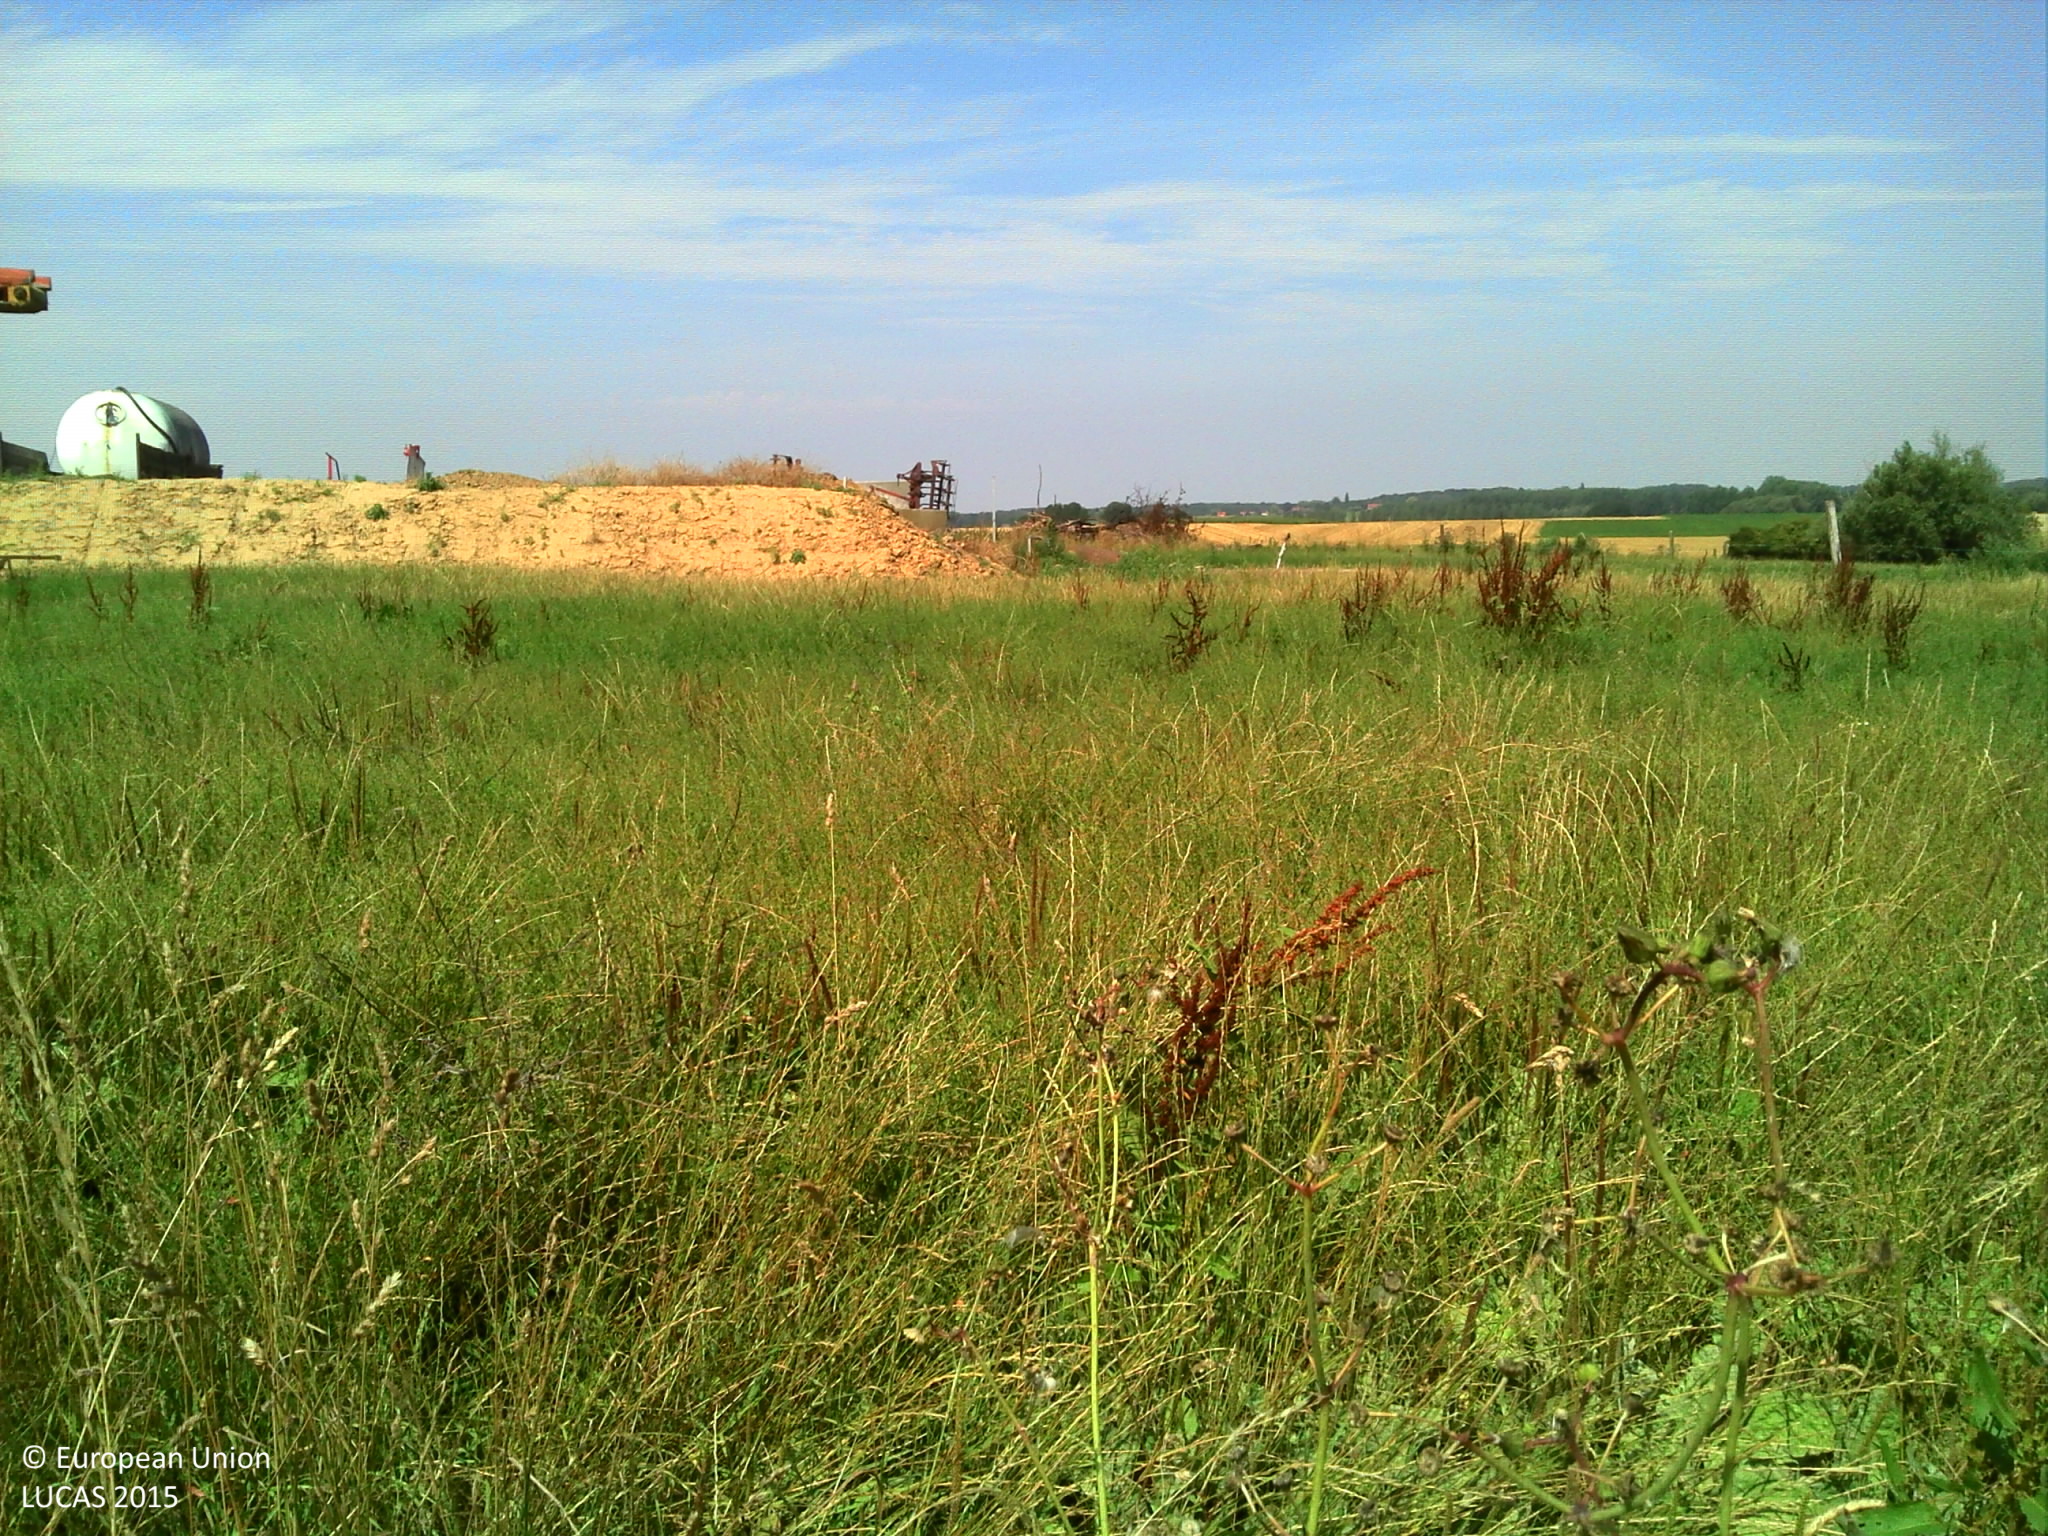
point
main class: Grassland
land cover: Grassland without tree/shrub cover
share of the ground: > 75 %
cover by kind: herbaceous plants 100 %
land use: Agriculture (excluding fallow land and kitchen gardens)
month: August
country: BE
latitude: 50.6893
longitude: 3.9213
